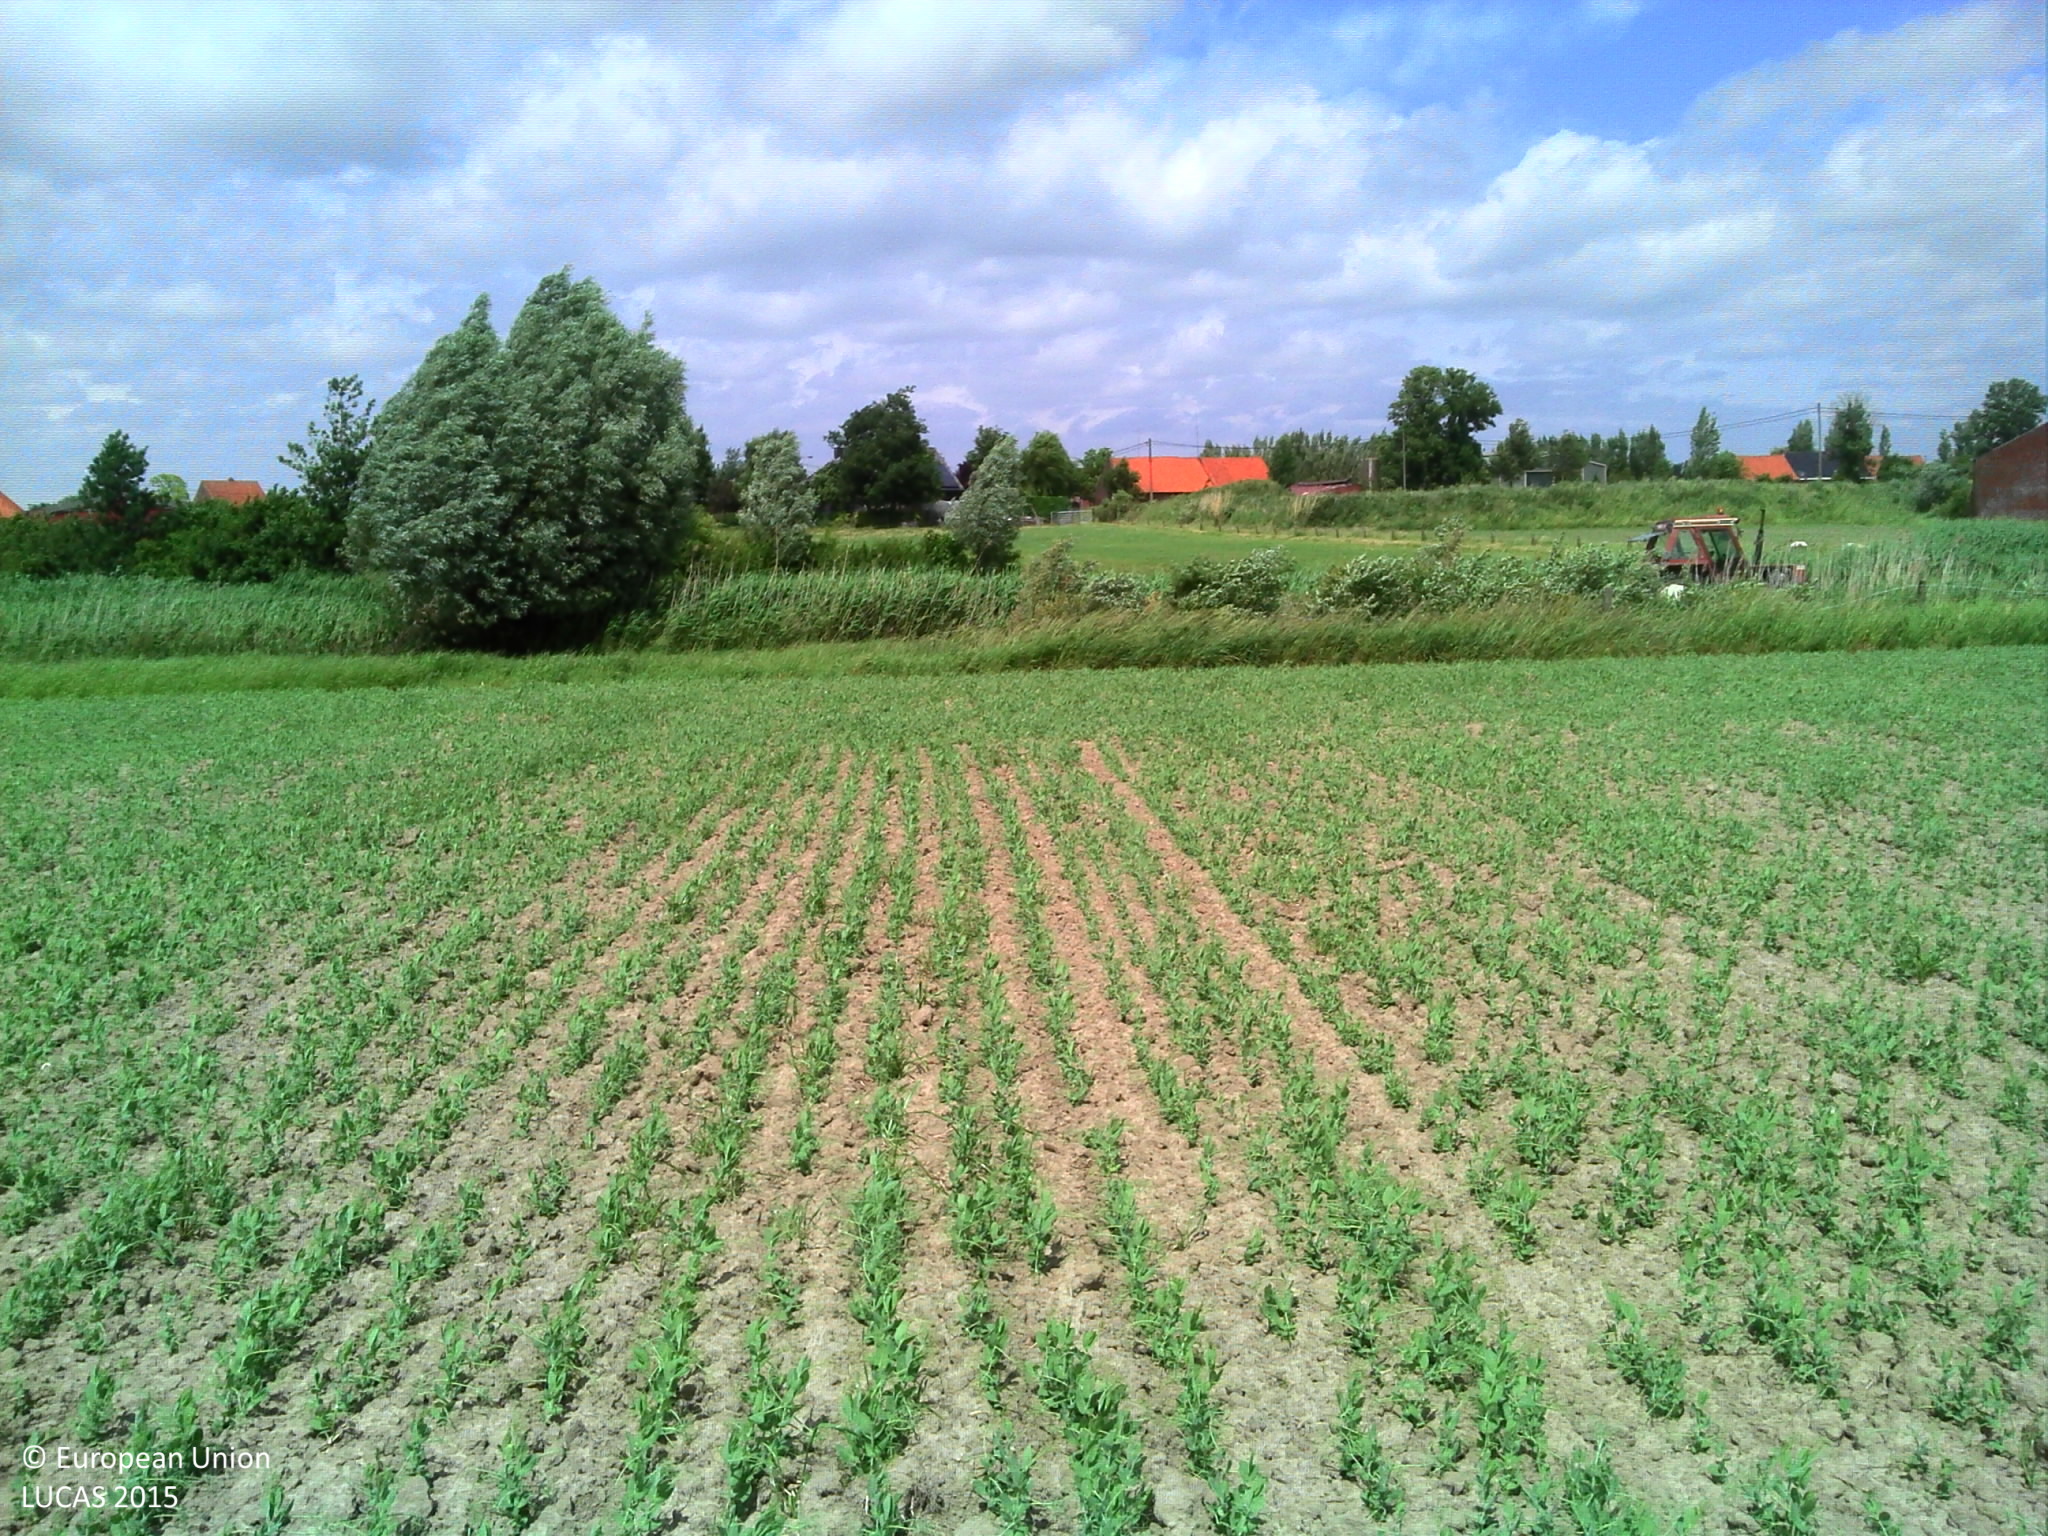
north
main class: Cropland
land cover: Dry pulses
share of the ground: 50 - 75 %
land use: Agriculture (excluding fallow land and kitchen gardens)
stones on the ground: < 10 %
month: June
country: BE
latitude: 51.0221
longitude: 3.1045
